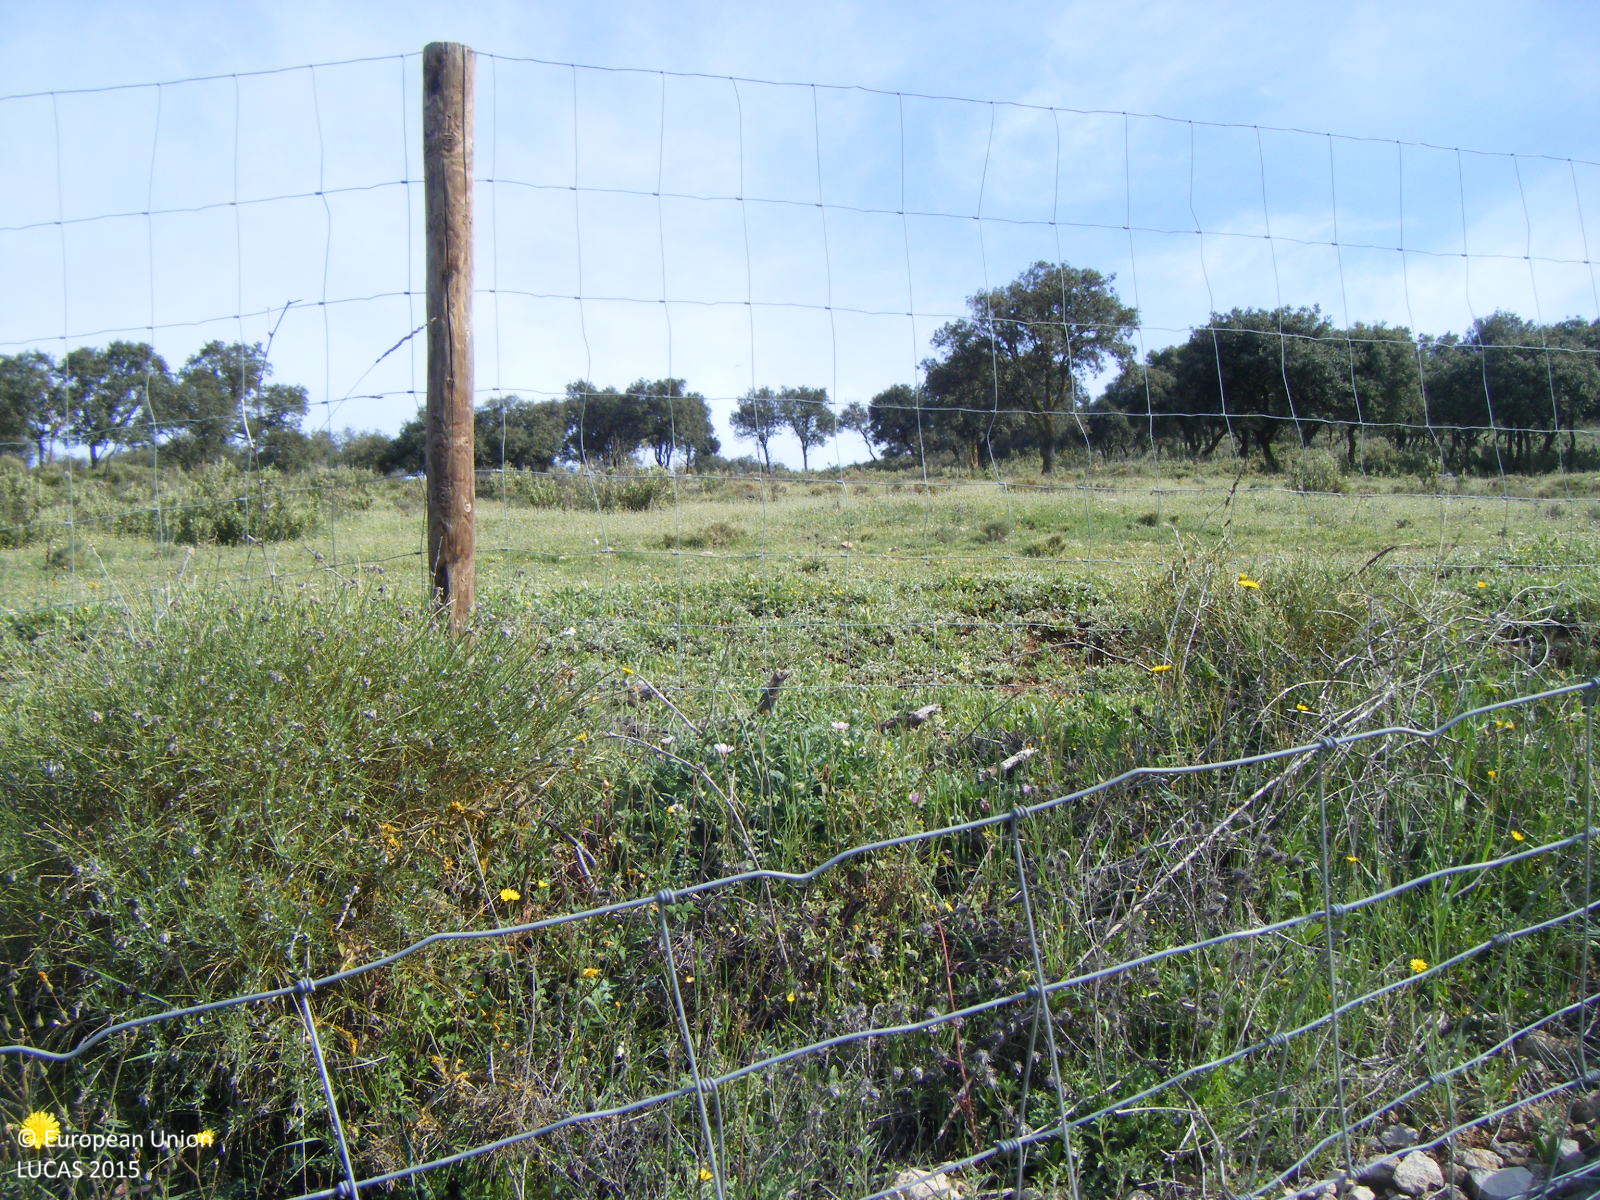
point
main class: Shrubland
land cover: Shrubland without tree cover
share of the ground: 25 - 50 %
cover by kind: herbaceous plants 60 %, shrubs 40 %
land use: Agriculture (excluding fallow land and kitchen gardens)
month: April
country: ES
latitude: 36.9543
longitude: -4.0617
